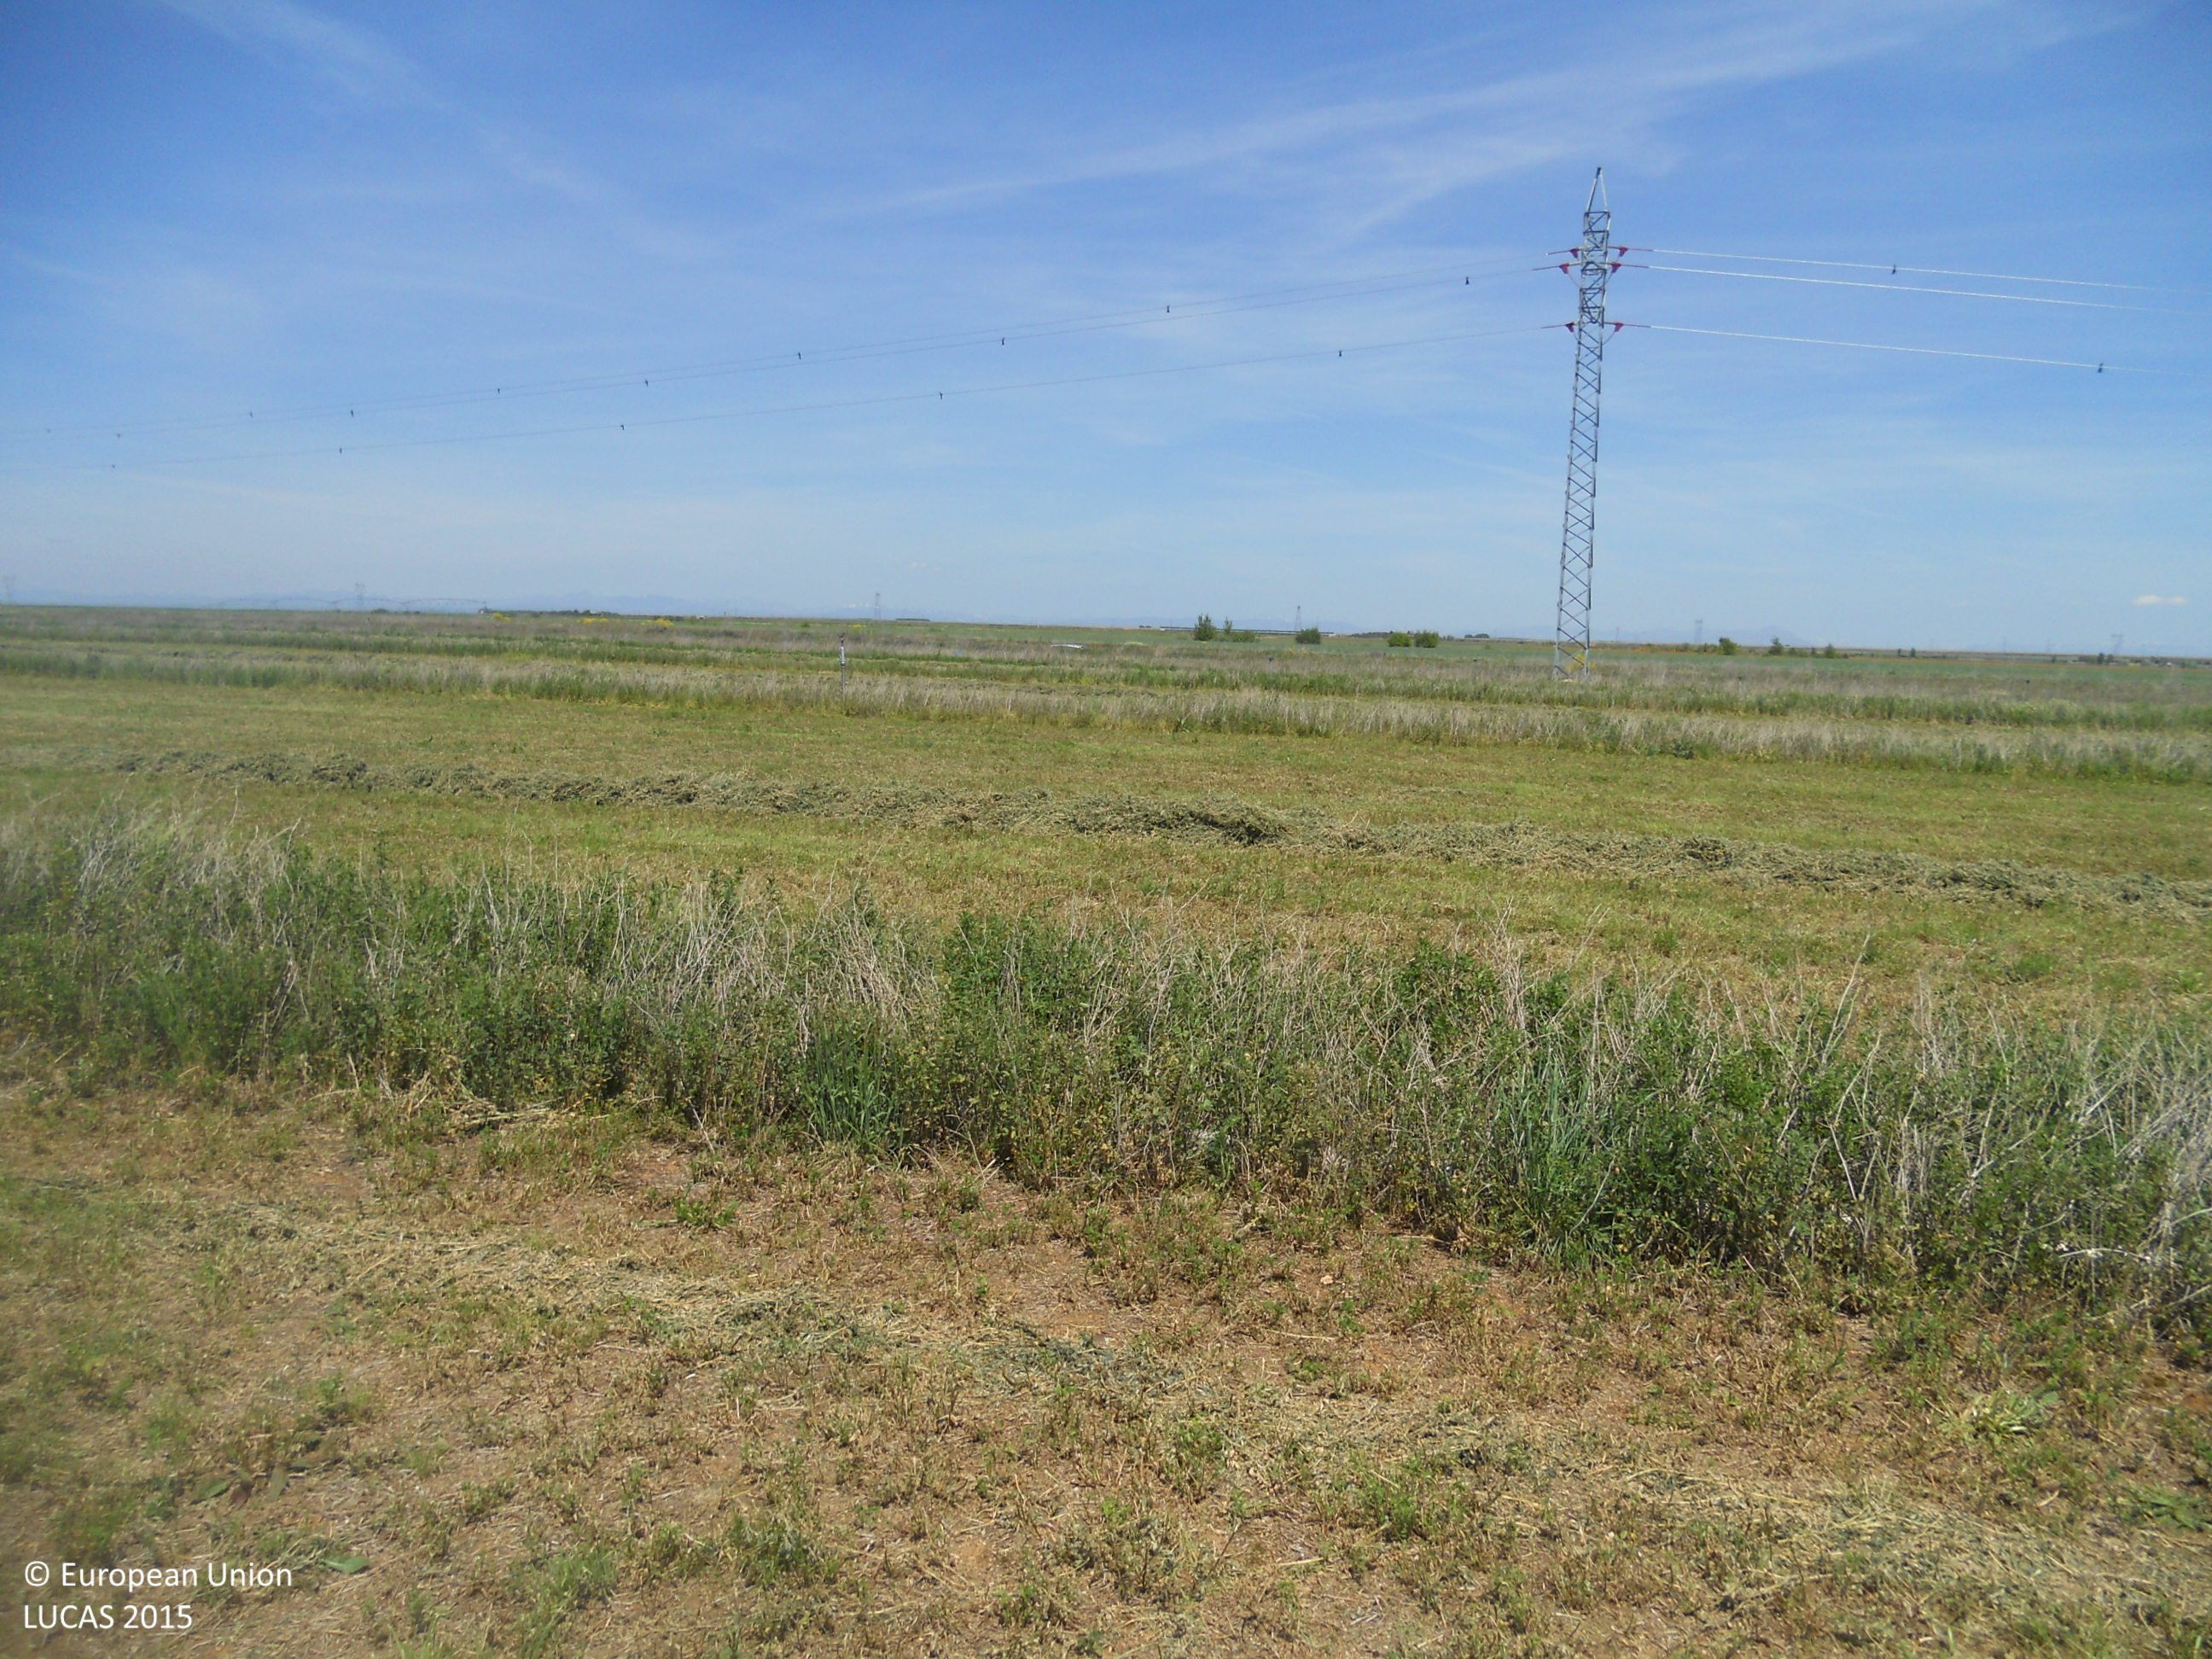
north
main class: Cropland
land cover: Lucerne
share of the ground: > 75 %
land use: Agriculture (excluding fallow land and kitchen gardens)
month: May
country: ES
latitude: 42.4028
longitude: -5.2883
